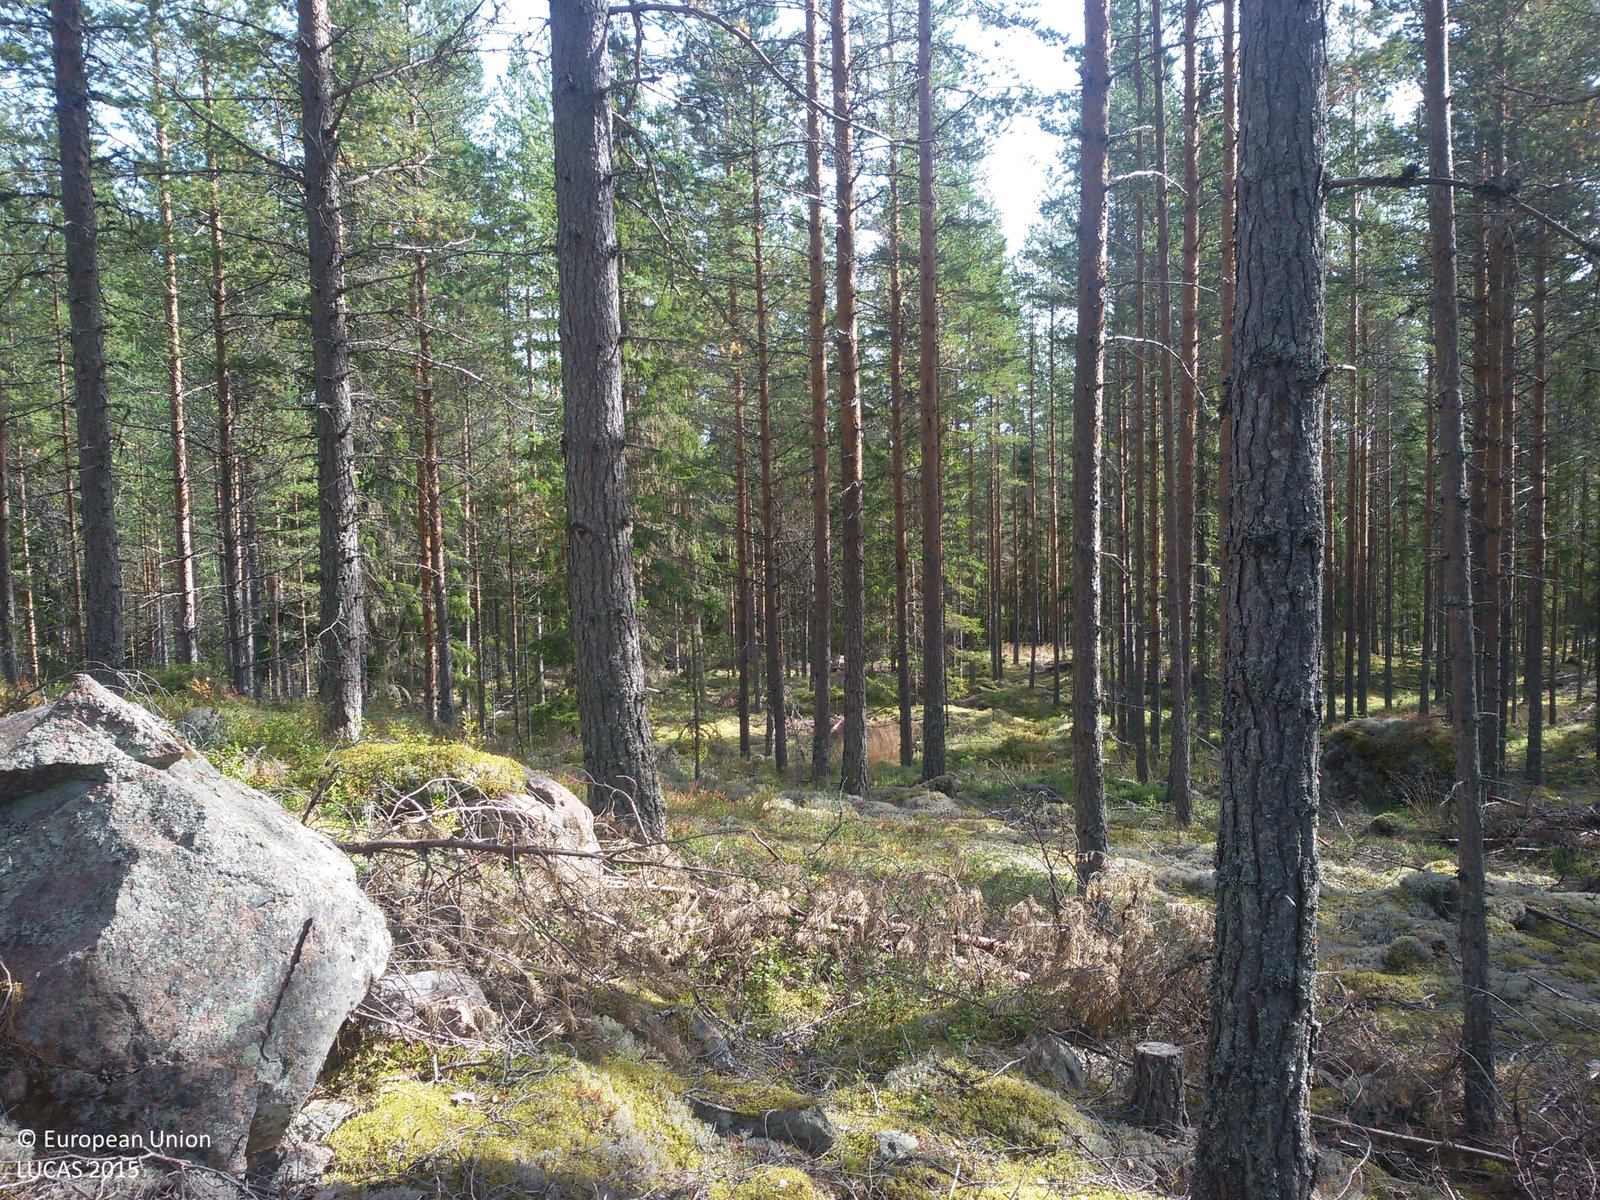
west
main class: Woodland
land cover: Pine dominated coniferous woodland
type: boreal forest
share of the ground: 50 - 75 %
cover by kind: coniferous forest trees 60 %, lichens and mosses 30 %, shrubs 10 %
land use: Forestry
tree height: > 5 m
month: September
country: SE
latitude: 61.0212
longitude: 15.2593
